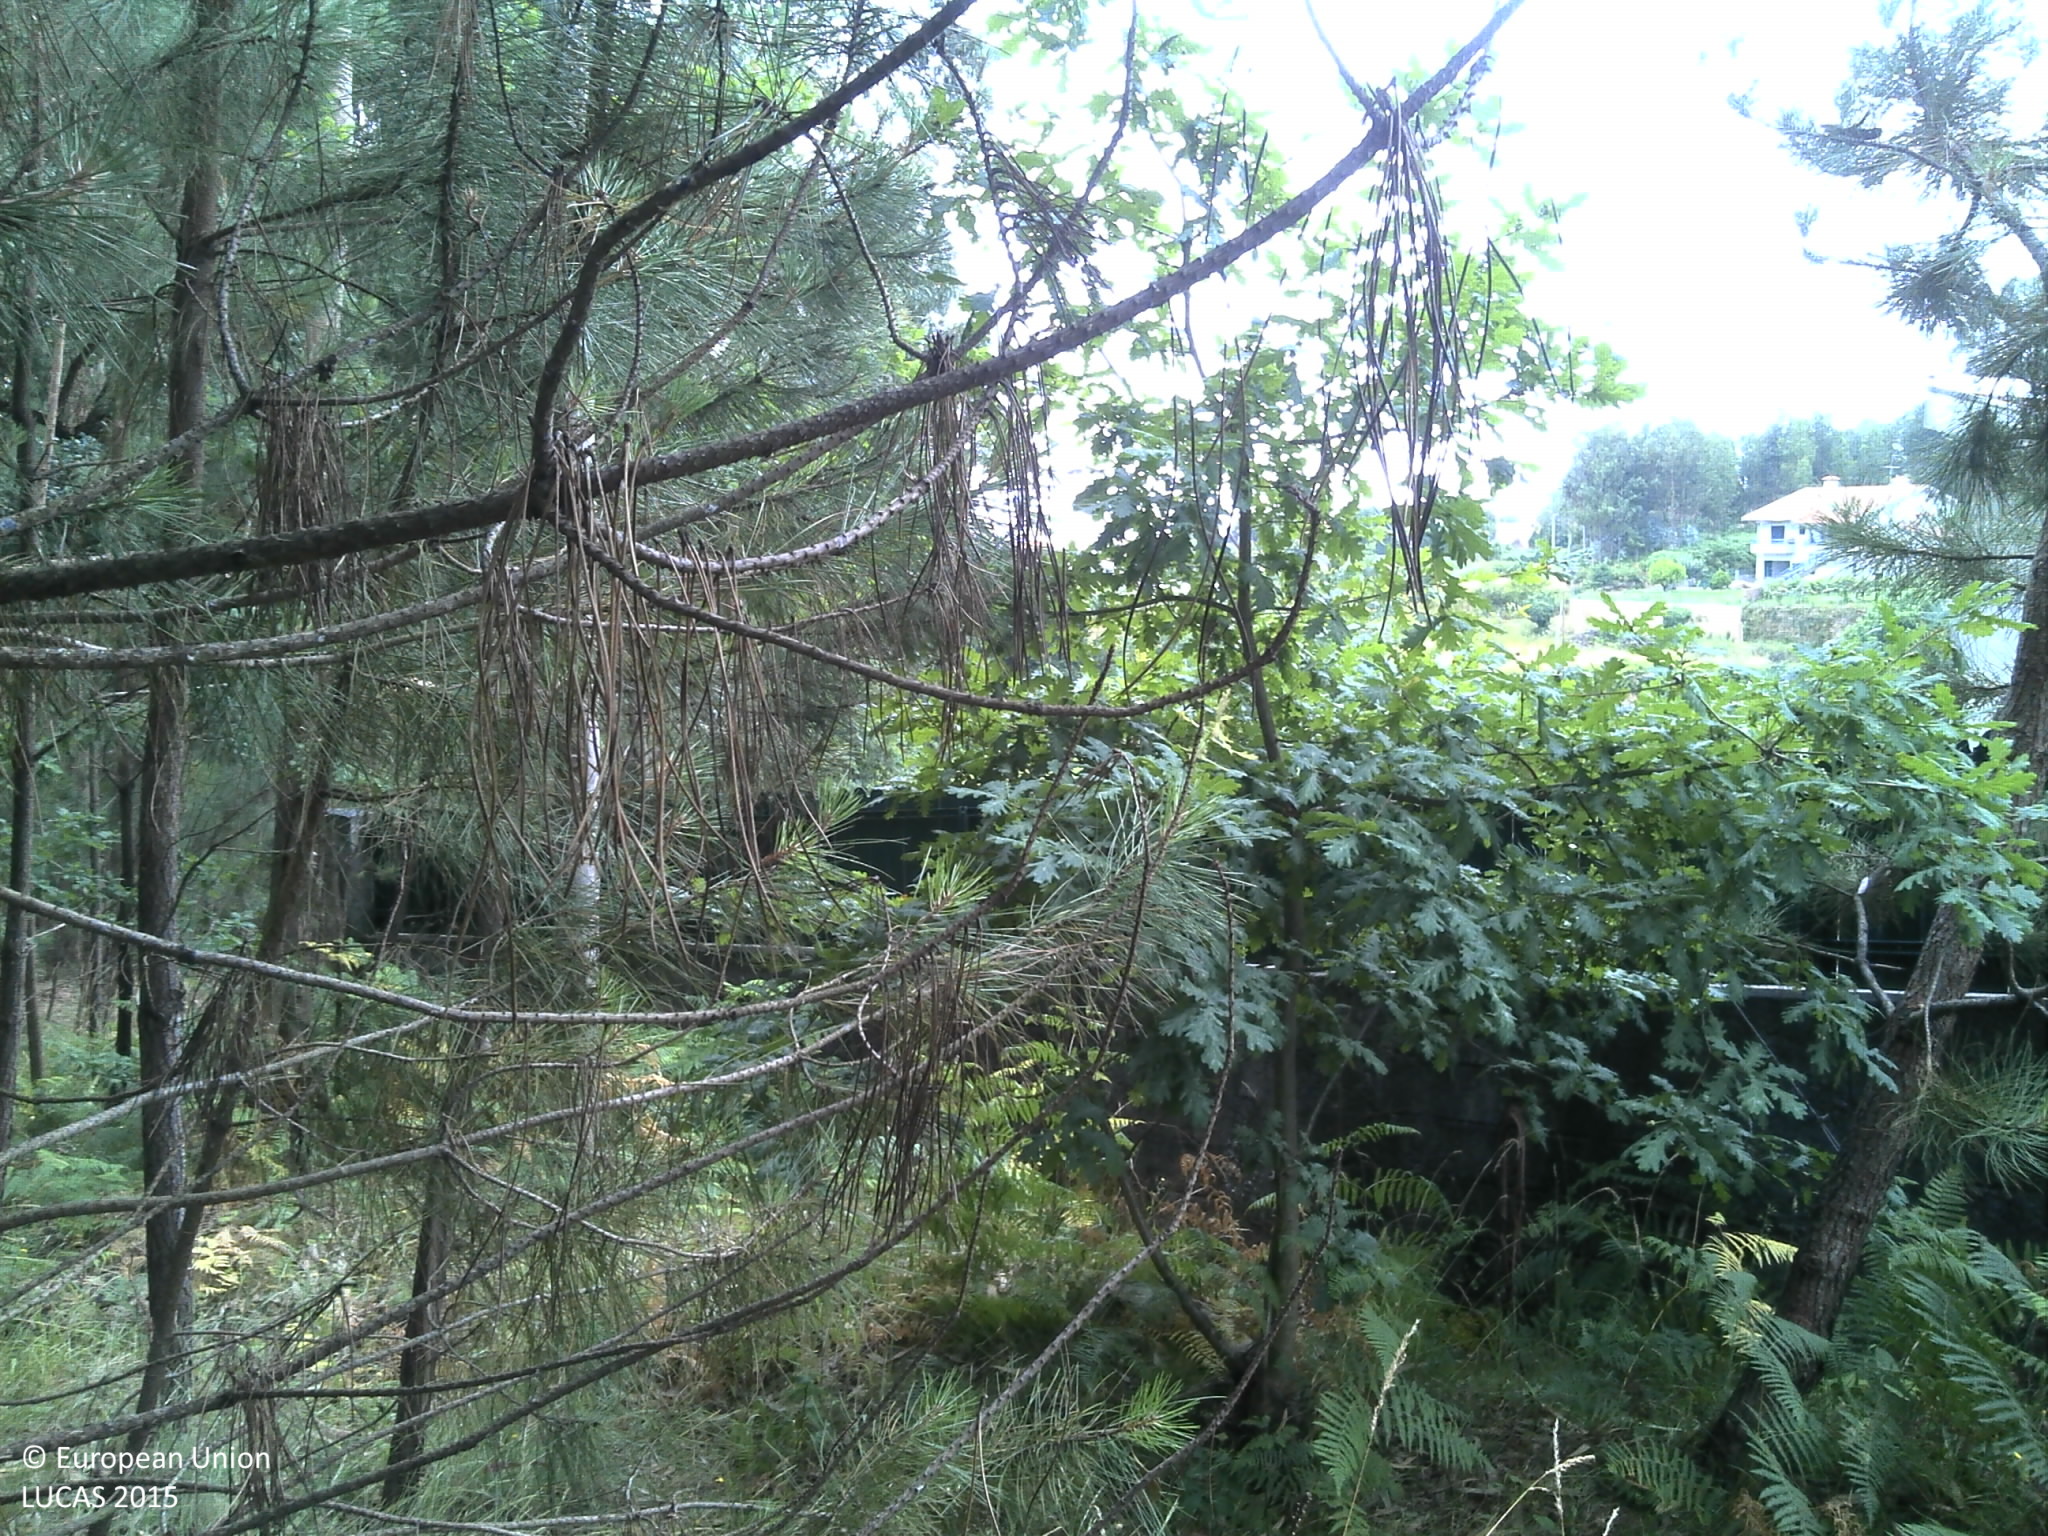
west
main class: Woodland
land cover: Pine dominated mixed woodland
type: coniferous forest of the mediterranean region
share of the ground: 50 - 75 %
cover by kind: coniferous forest trees 50 %, broadleaved forest trees 25 %, herbaceous plants 15 %, shrubs 5 %, unconsolidated bare surface 5 %
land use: Forestry
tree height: > 5 m
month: June
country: PT
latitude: 40.7888
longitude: -8.4754
